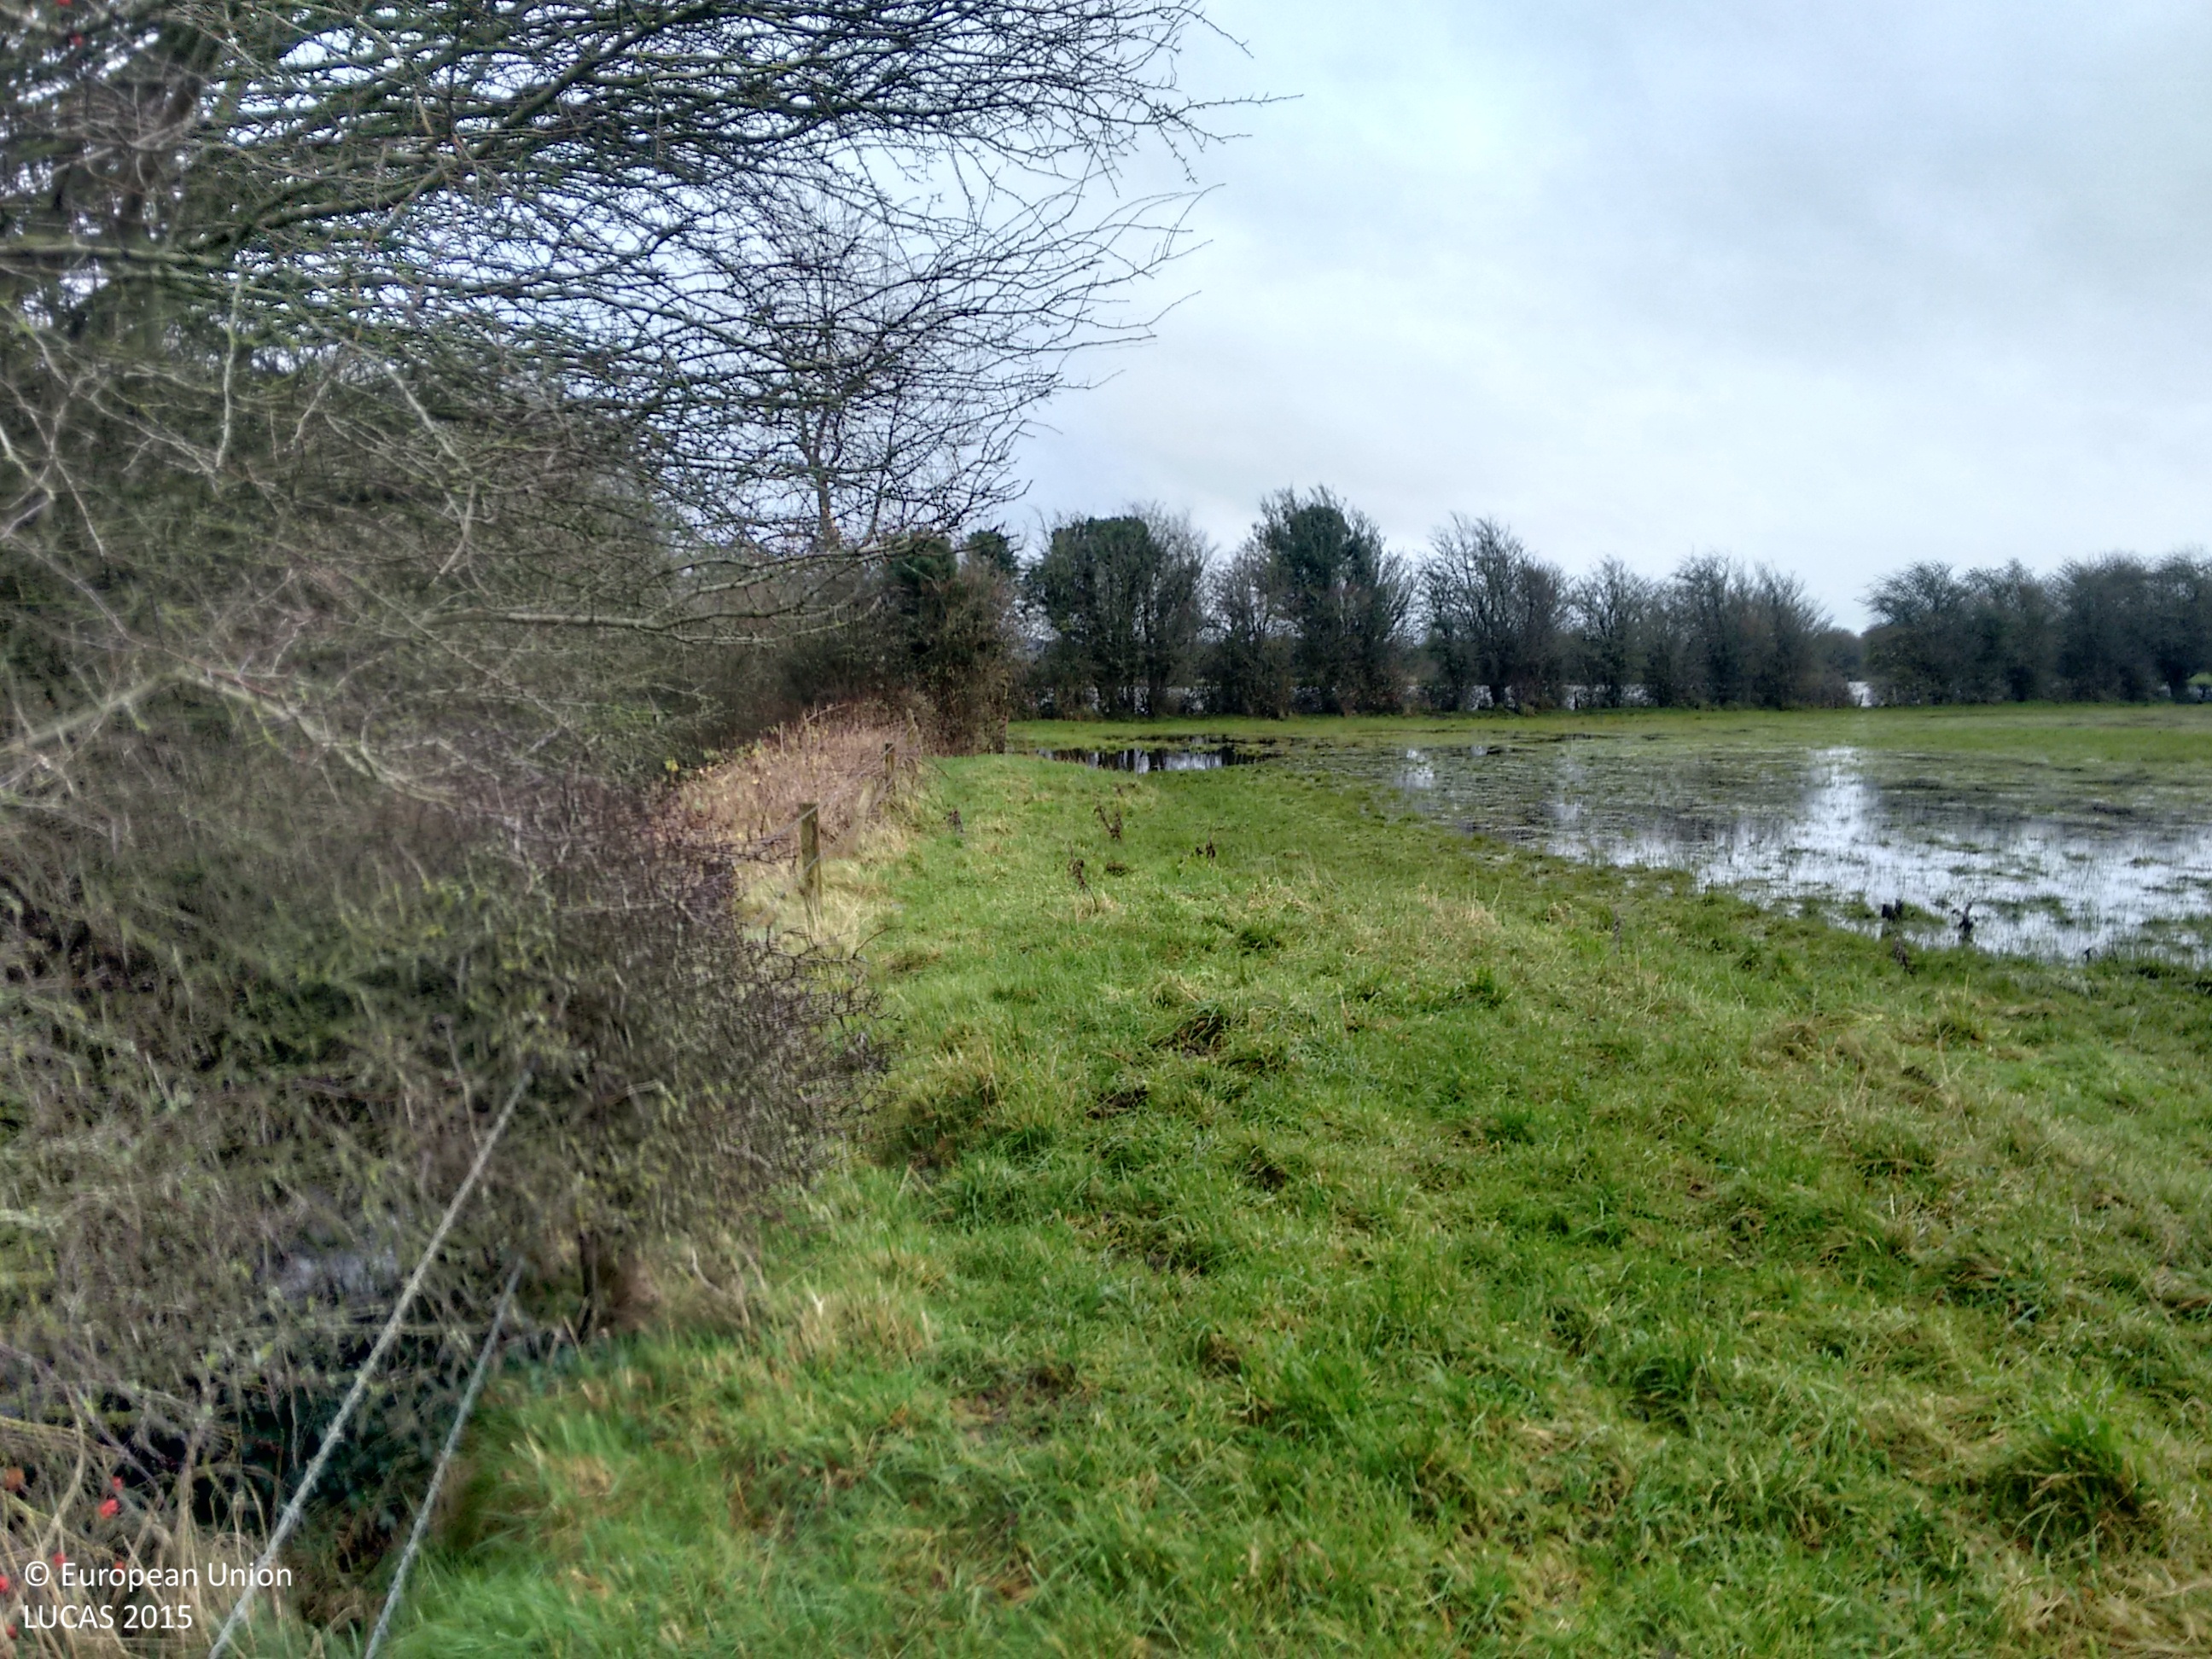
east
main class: Grassland
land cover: Grassland without tree/shrub cover
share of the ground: 50 - 75 %
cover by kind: herbaceous plants 95 %
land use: Agriculture (excluding fallow land and kitchen gardens)
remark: Temporary flooded
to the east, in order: Grassland without tree/shrub cover; Fences; Abandoned hedges; Fences; Grassland without tree/shrub cover; Fences; Abandoned hedges; Rivers and streams; Abandoned hedges; Fences; Grassland without tree/shrub cover; Fences; Abandoned hedges; Grassland without tree/shrub cover
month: December
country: IE
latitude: 53.3114
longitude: -7.8662
